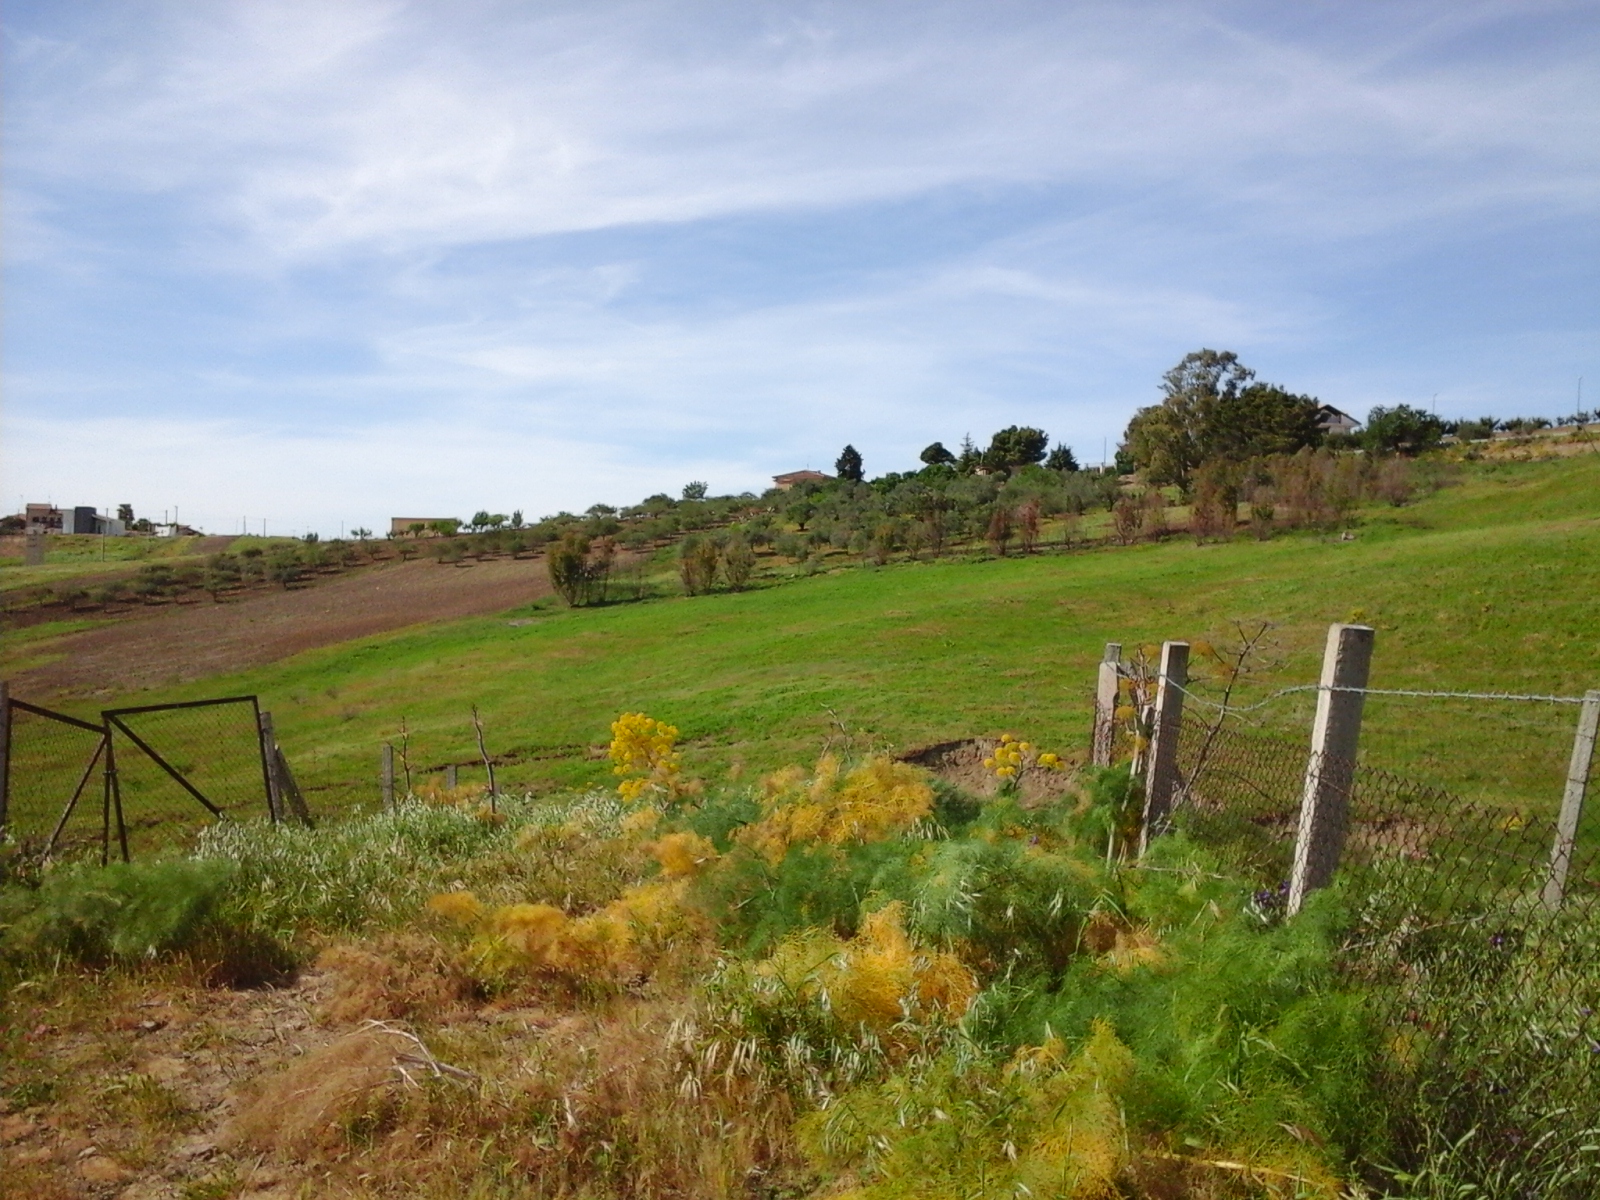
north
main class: Grassland
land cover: Spontaneously vegetated surfaces
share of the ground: > 75 %
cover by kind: herbaceous plants 100 %
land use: Fallow land
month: May
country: IT
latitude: 37.4813
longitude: 14.0071
